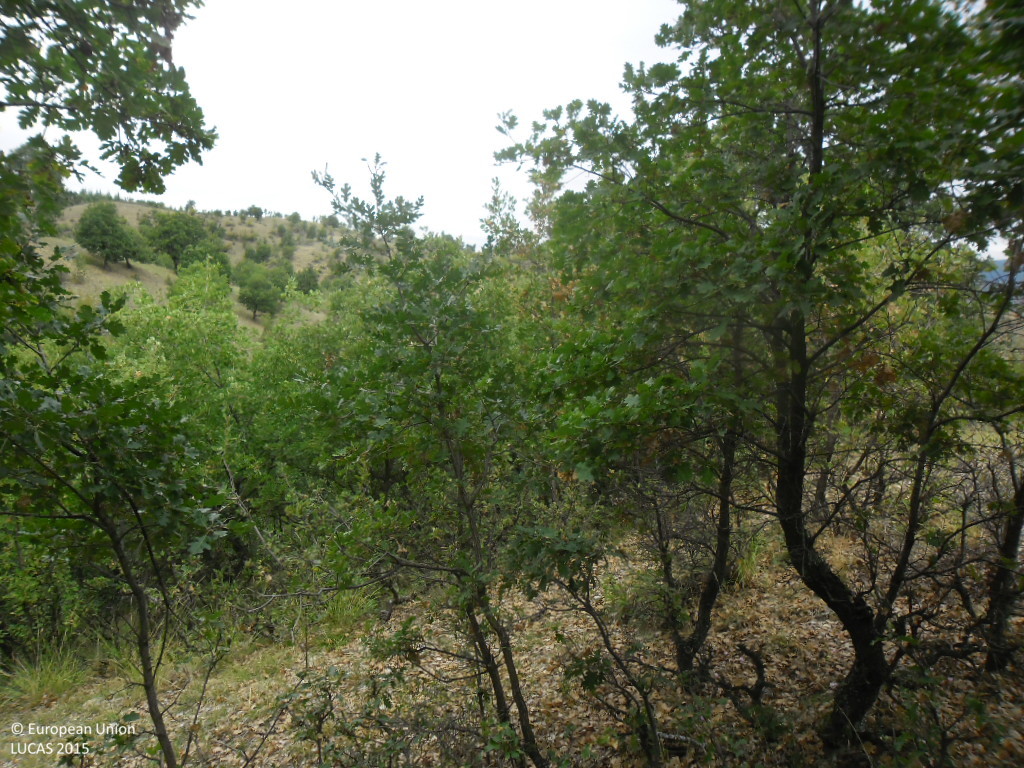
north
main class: Woodland
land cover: Broadleaved woodland
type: thermophilous deciduous forest
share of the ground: > 75 %
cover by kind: broadleaved forest trees 95 %, unconsolidated bare surface 5 %
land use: Forestry
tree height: < 5 m
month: September
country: BG
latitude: 41.6053
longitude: 23.1839
